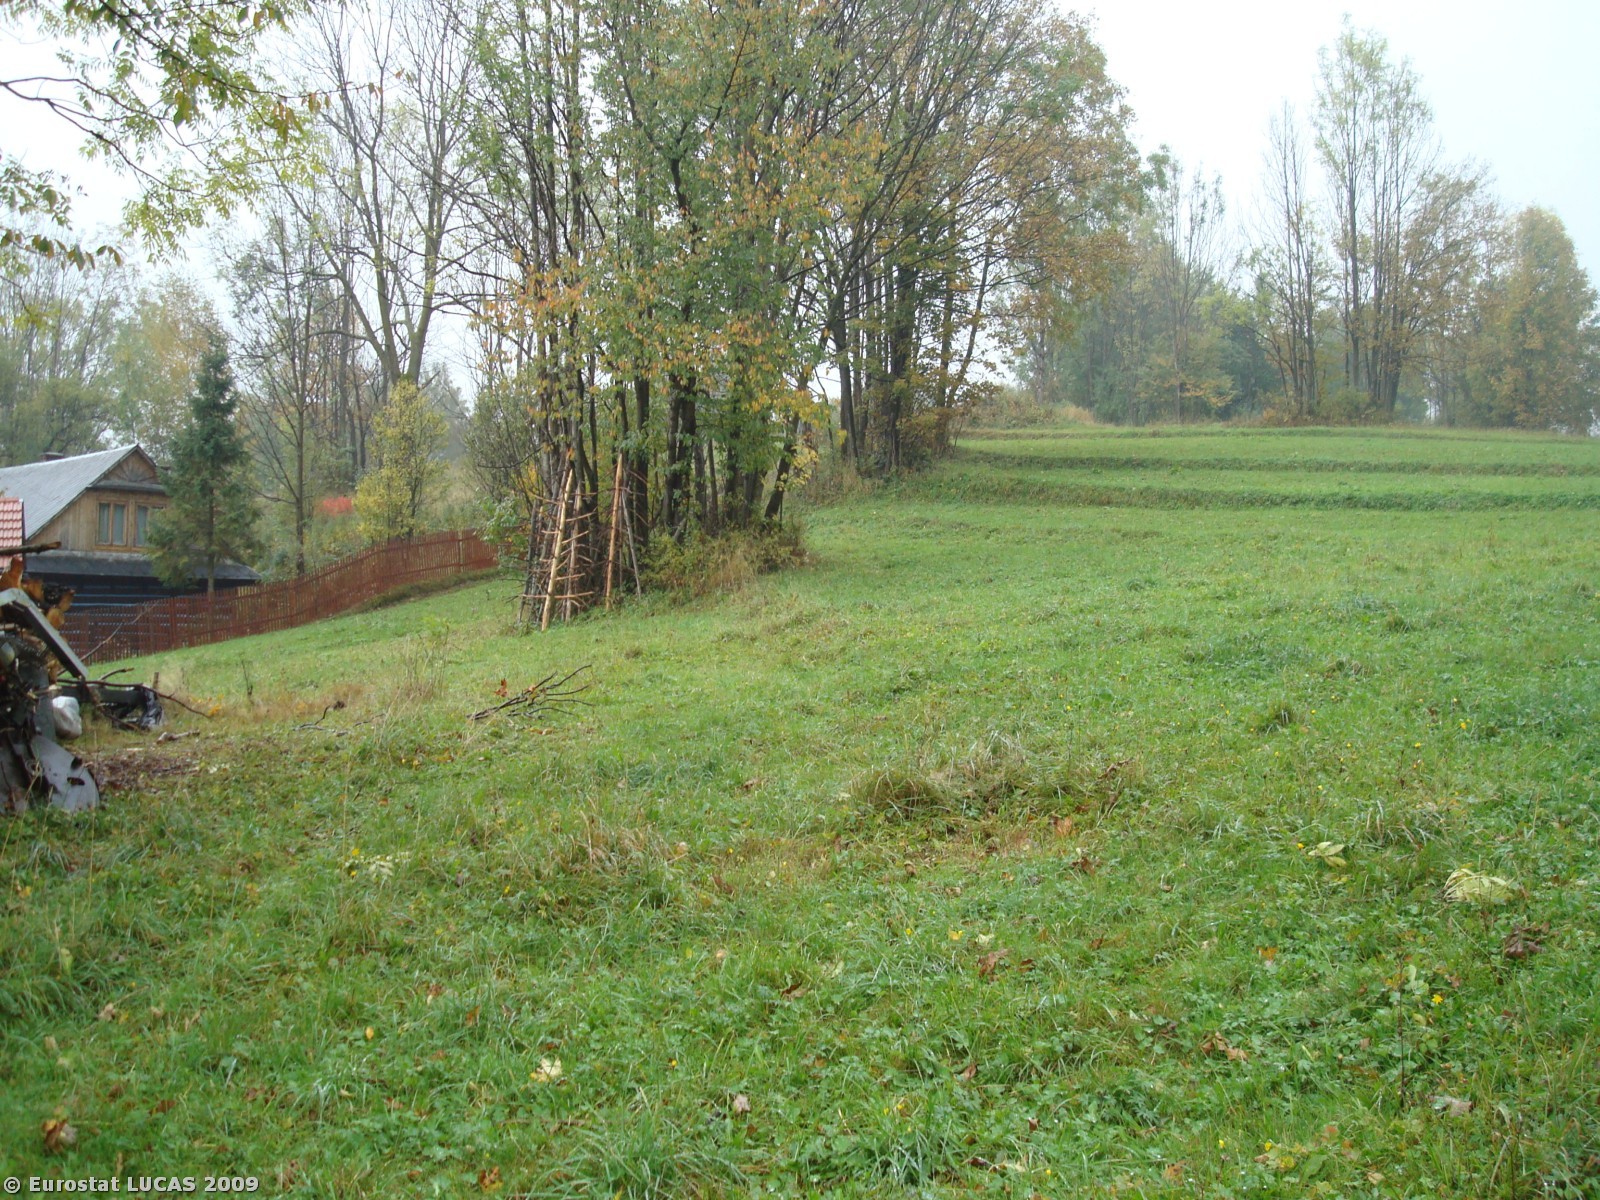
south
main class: Grassland
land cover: Grassland without tree/shrub cover
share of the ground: > 75 %
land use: Unused
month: September
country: PL
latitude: 49.6493
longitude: 19.6263
